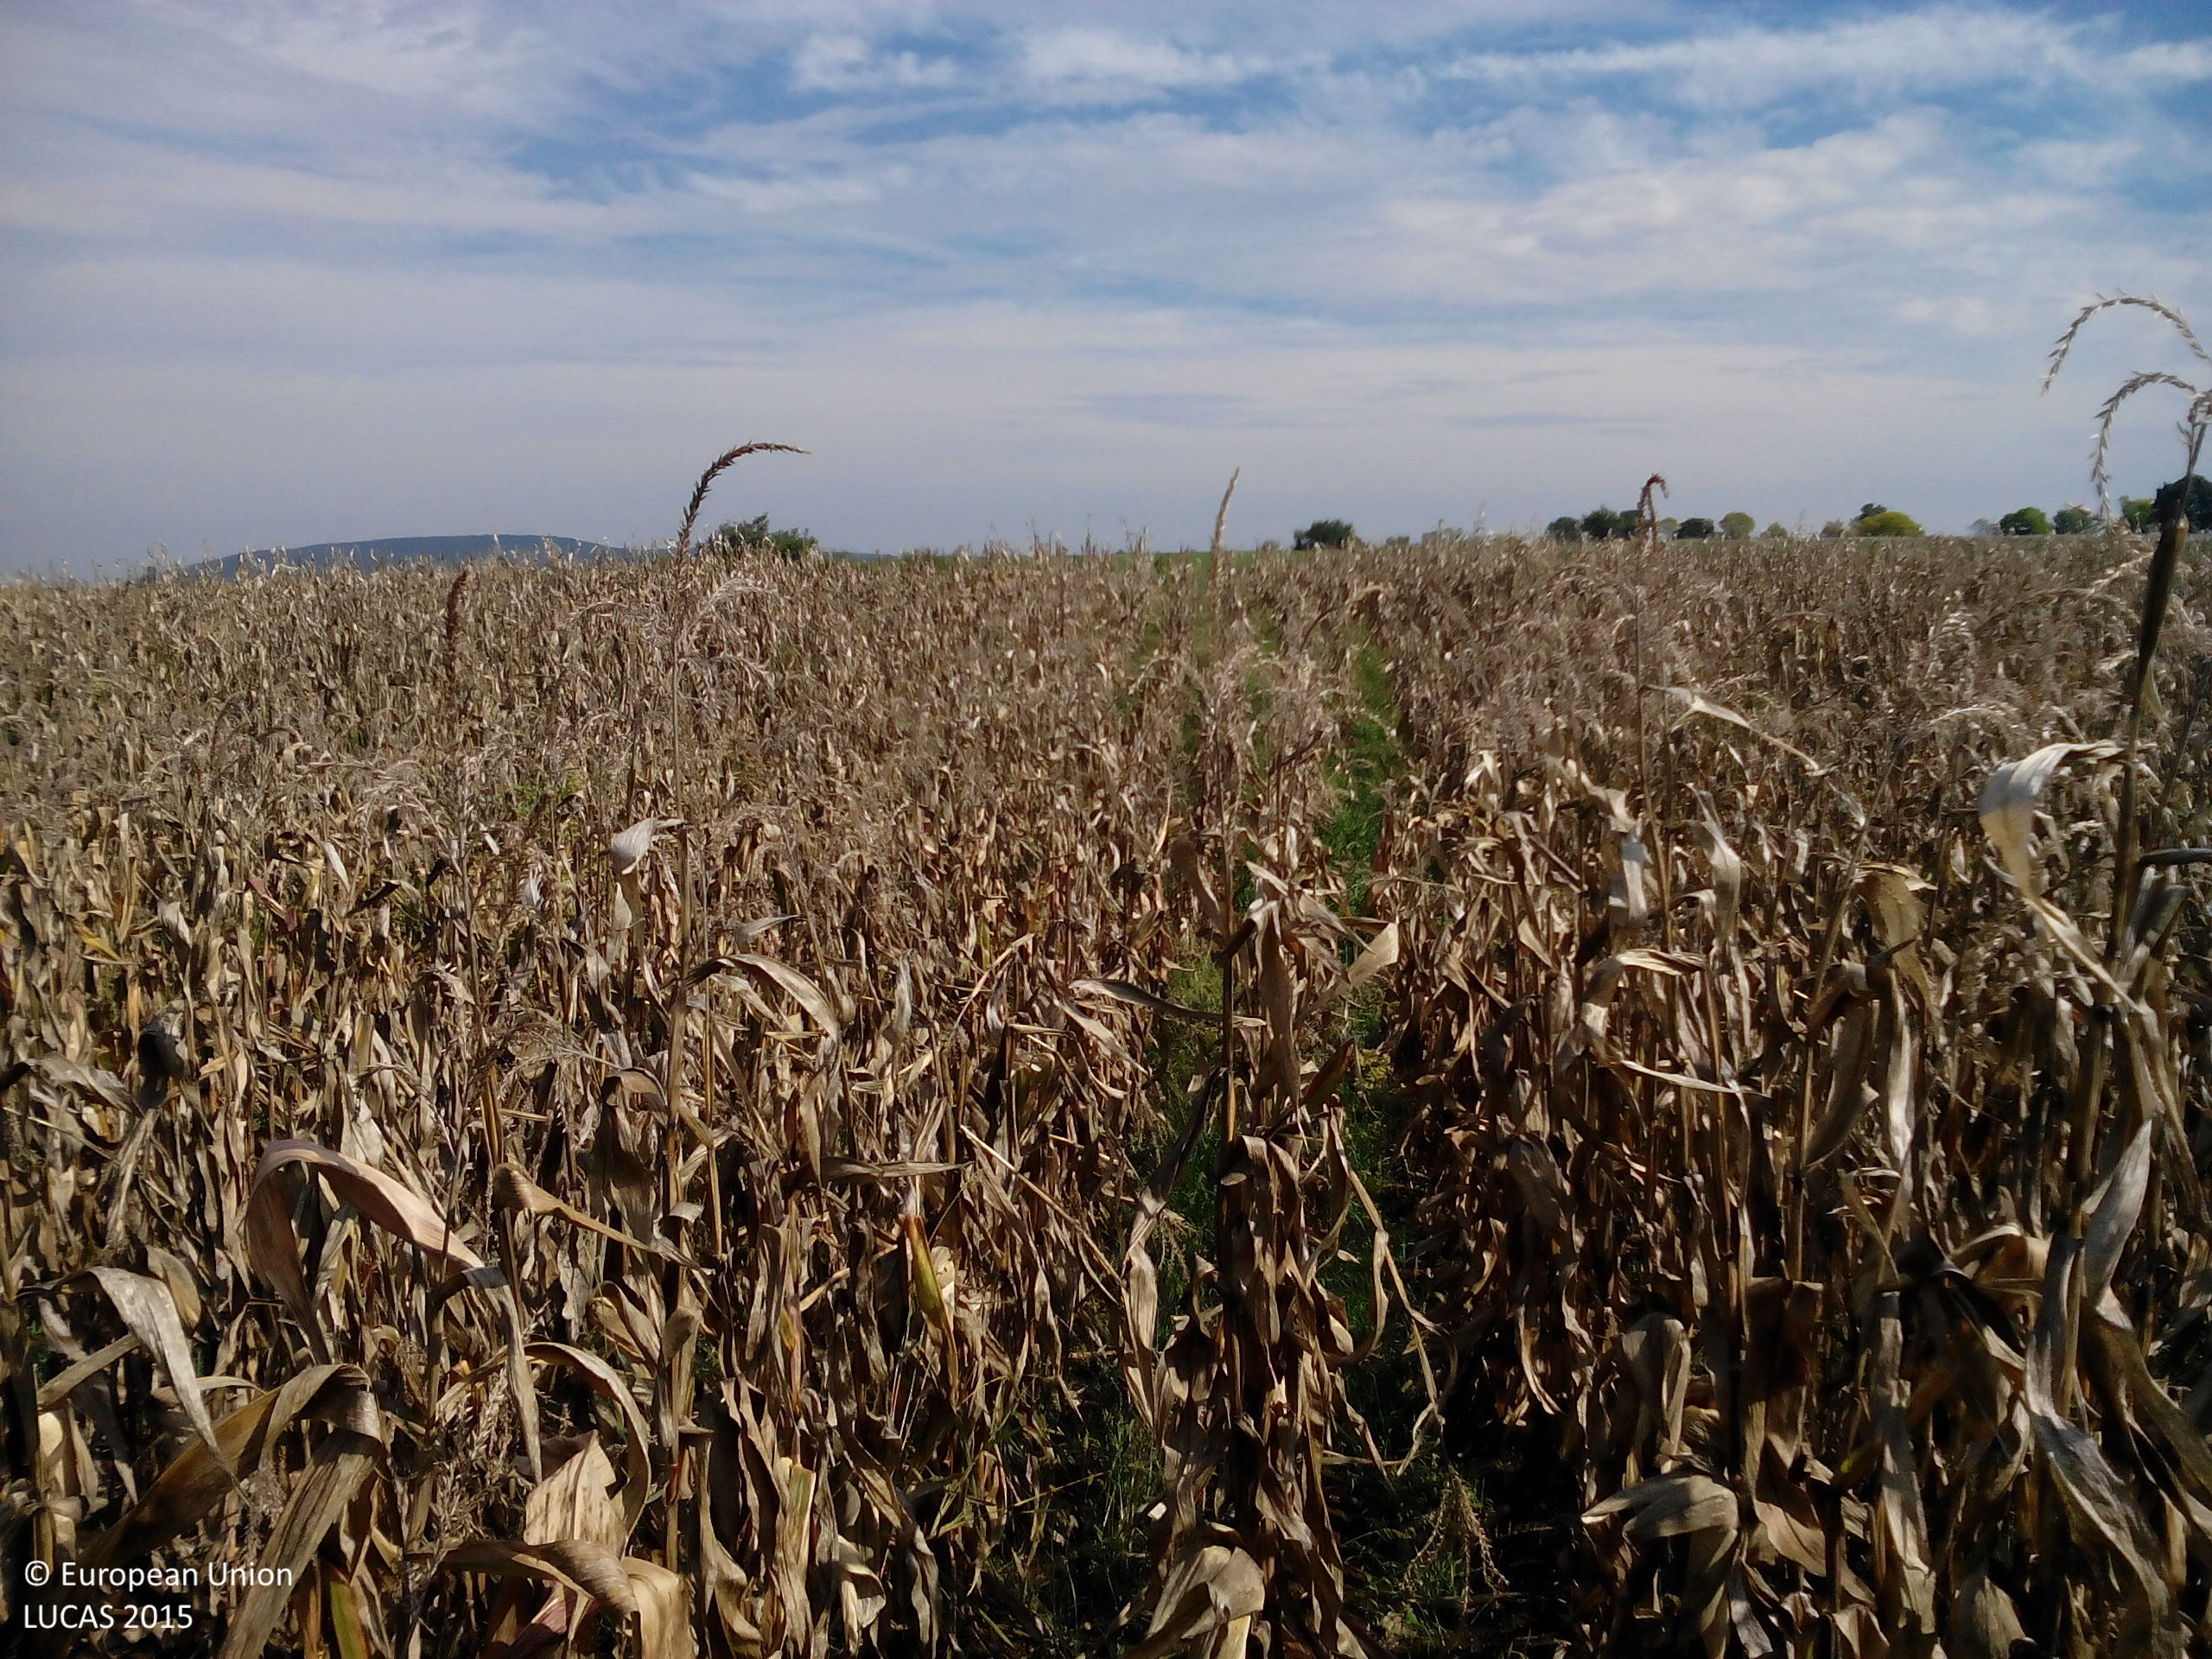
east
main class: Cropland
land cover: Maize
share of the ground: > 75 %
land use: Agriculture (excluding fallow land and kitchen gardens)
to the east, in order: Maize; Broadleaved woodland; Grassland with sparse tree/shrub cover; Rivers and streams; Grassland with sparse tree/shrub cover; Shrubland with sparse tree cover; Common wheat
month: October
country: BG
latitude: 43.3485
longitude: 23.6781
